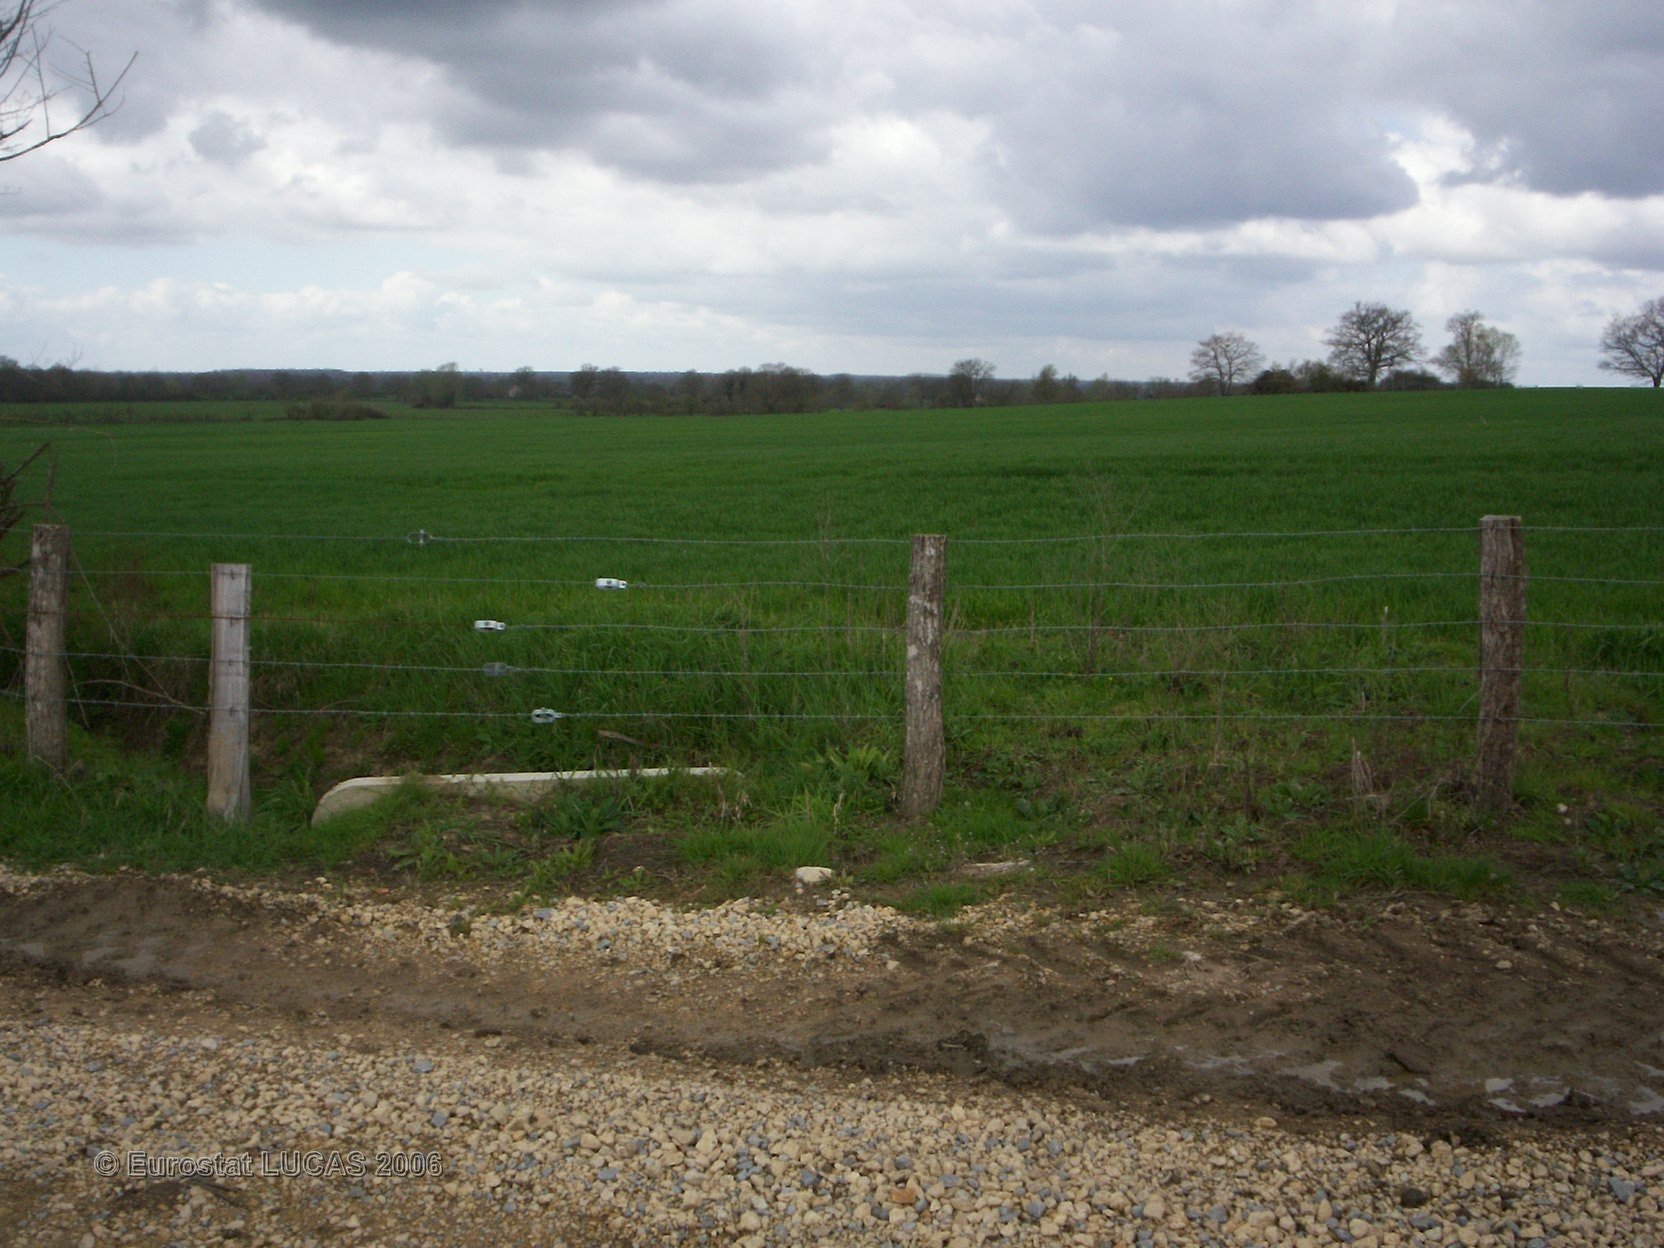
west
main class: Grassland
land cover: Grassland without tree/shrub cover
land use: Agriculture (excluding fallow land and kitchen gardens)
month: April
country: FR
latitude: 46.8698
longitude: 3.1088
